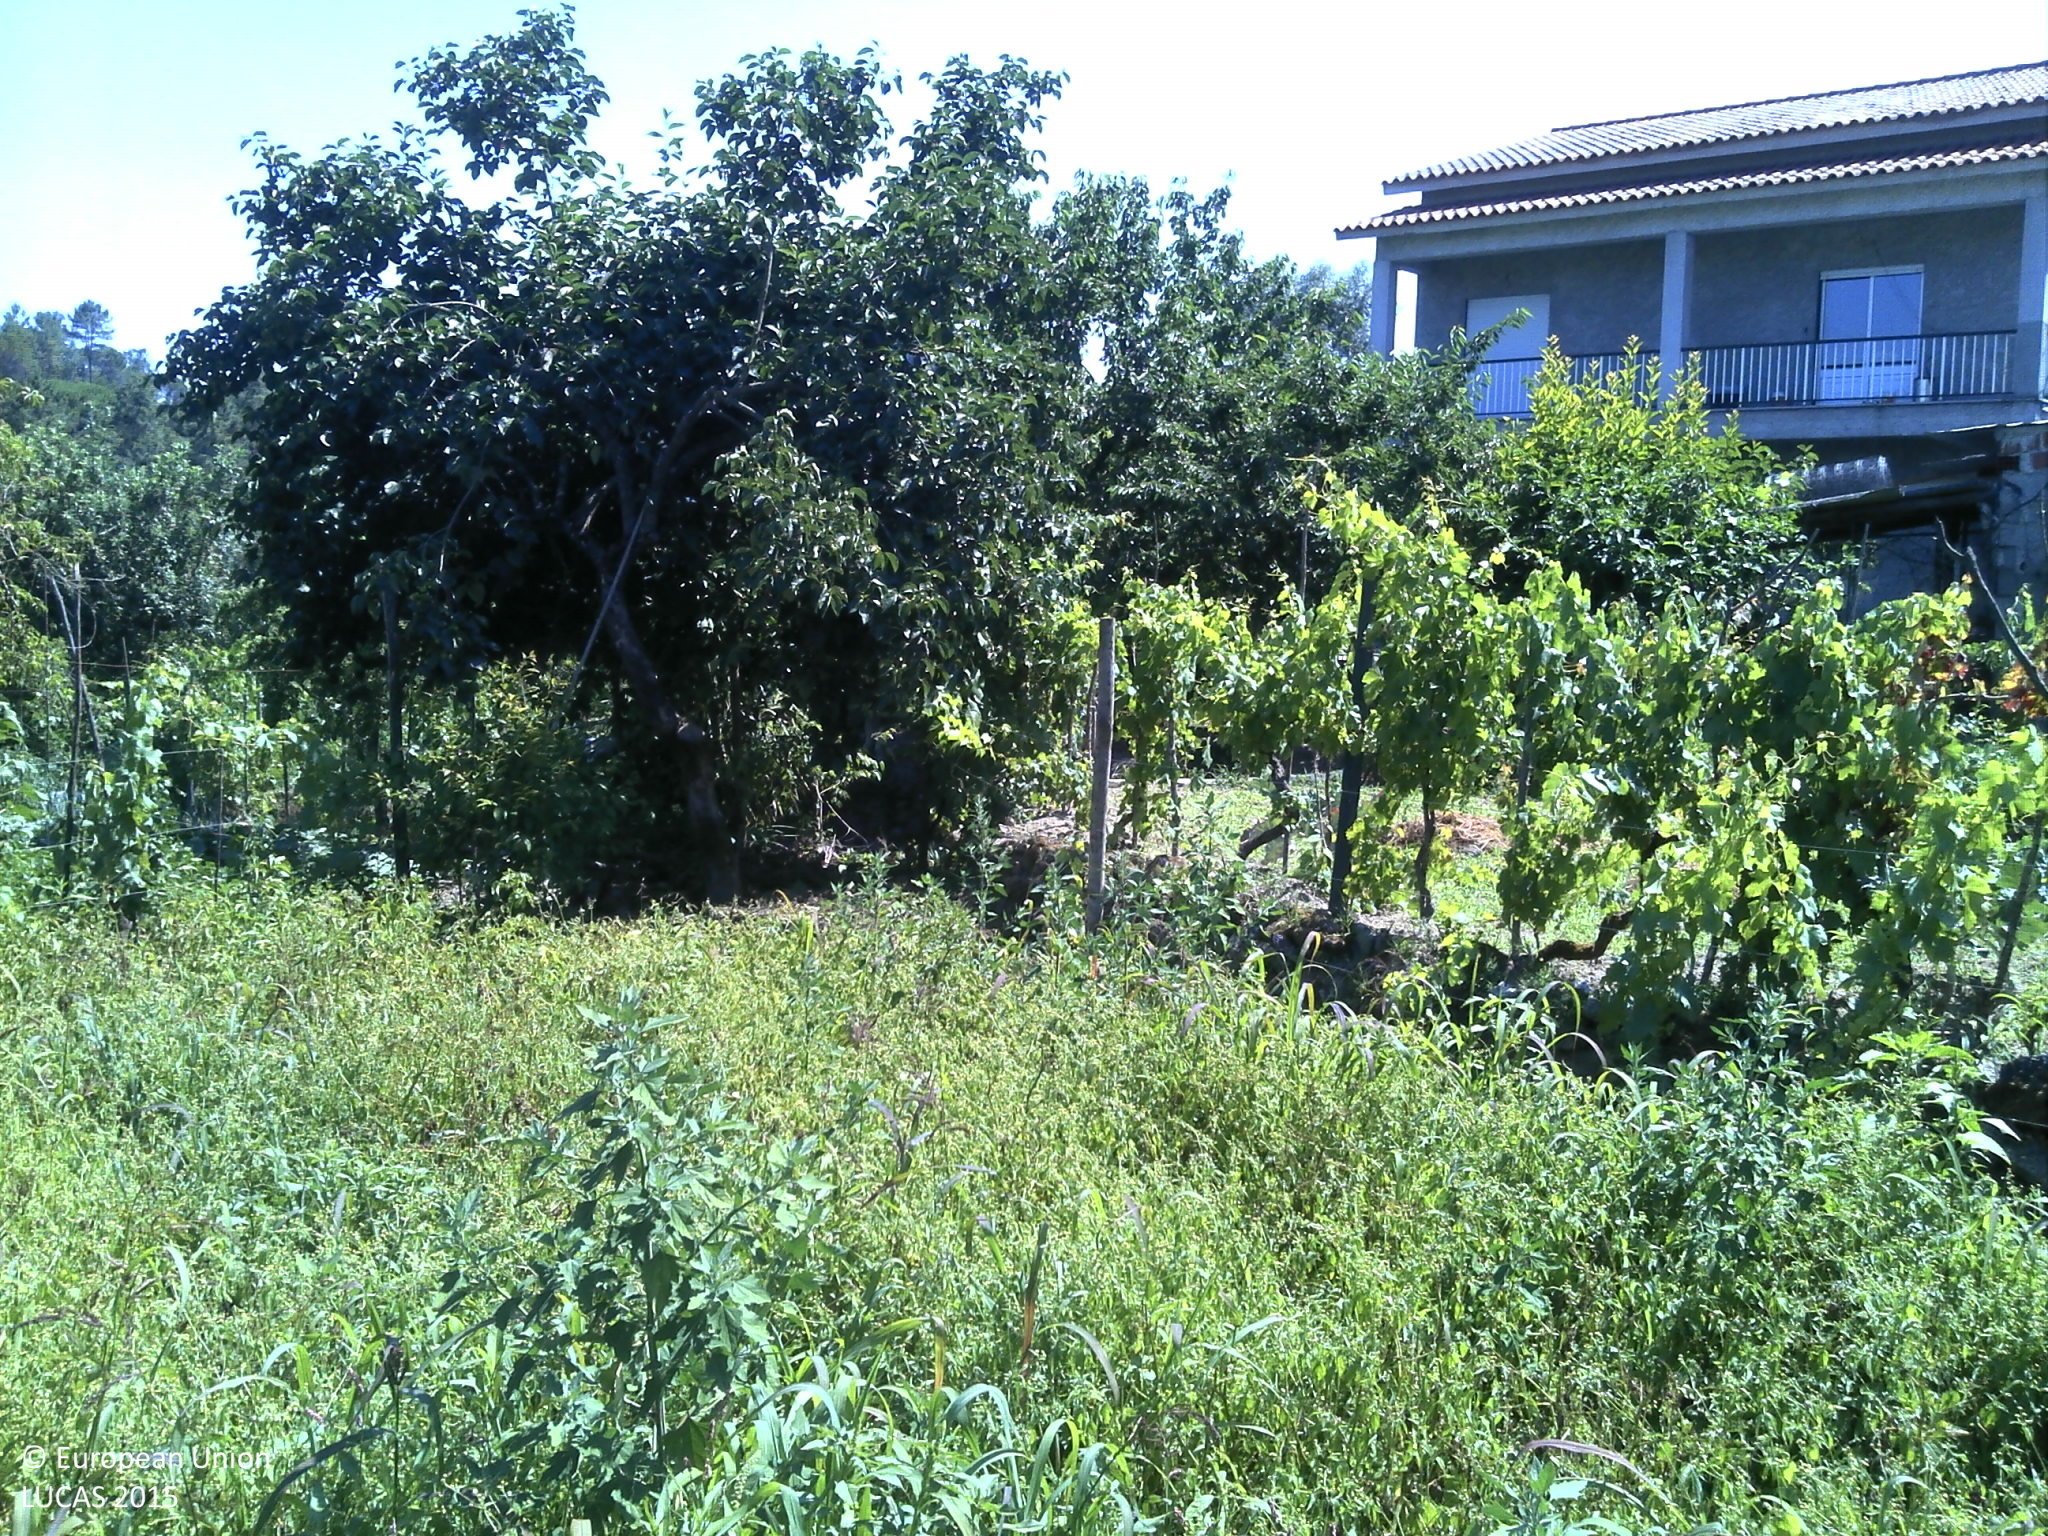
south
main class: Grassland
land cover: Spontaneously vegetated surfaces
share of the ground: > 75 %
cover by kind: herbaceous plants 90 %, unconsolidated bare surface 10 %
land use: Fallow land
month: June
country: PT
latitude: 40.6042
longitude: -7.9824
